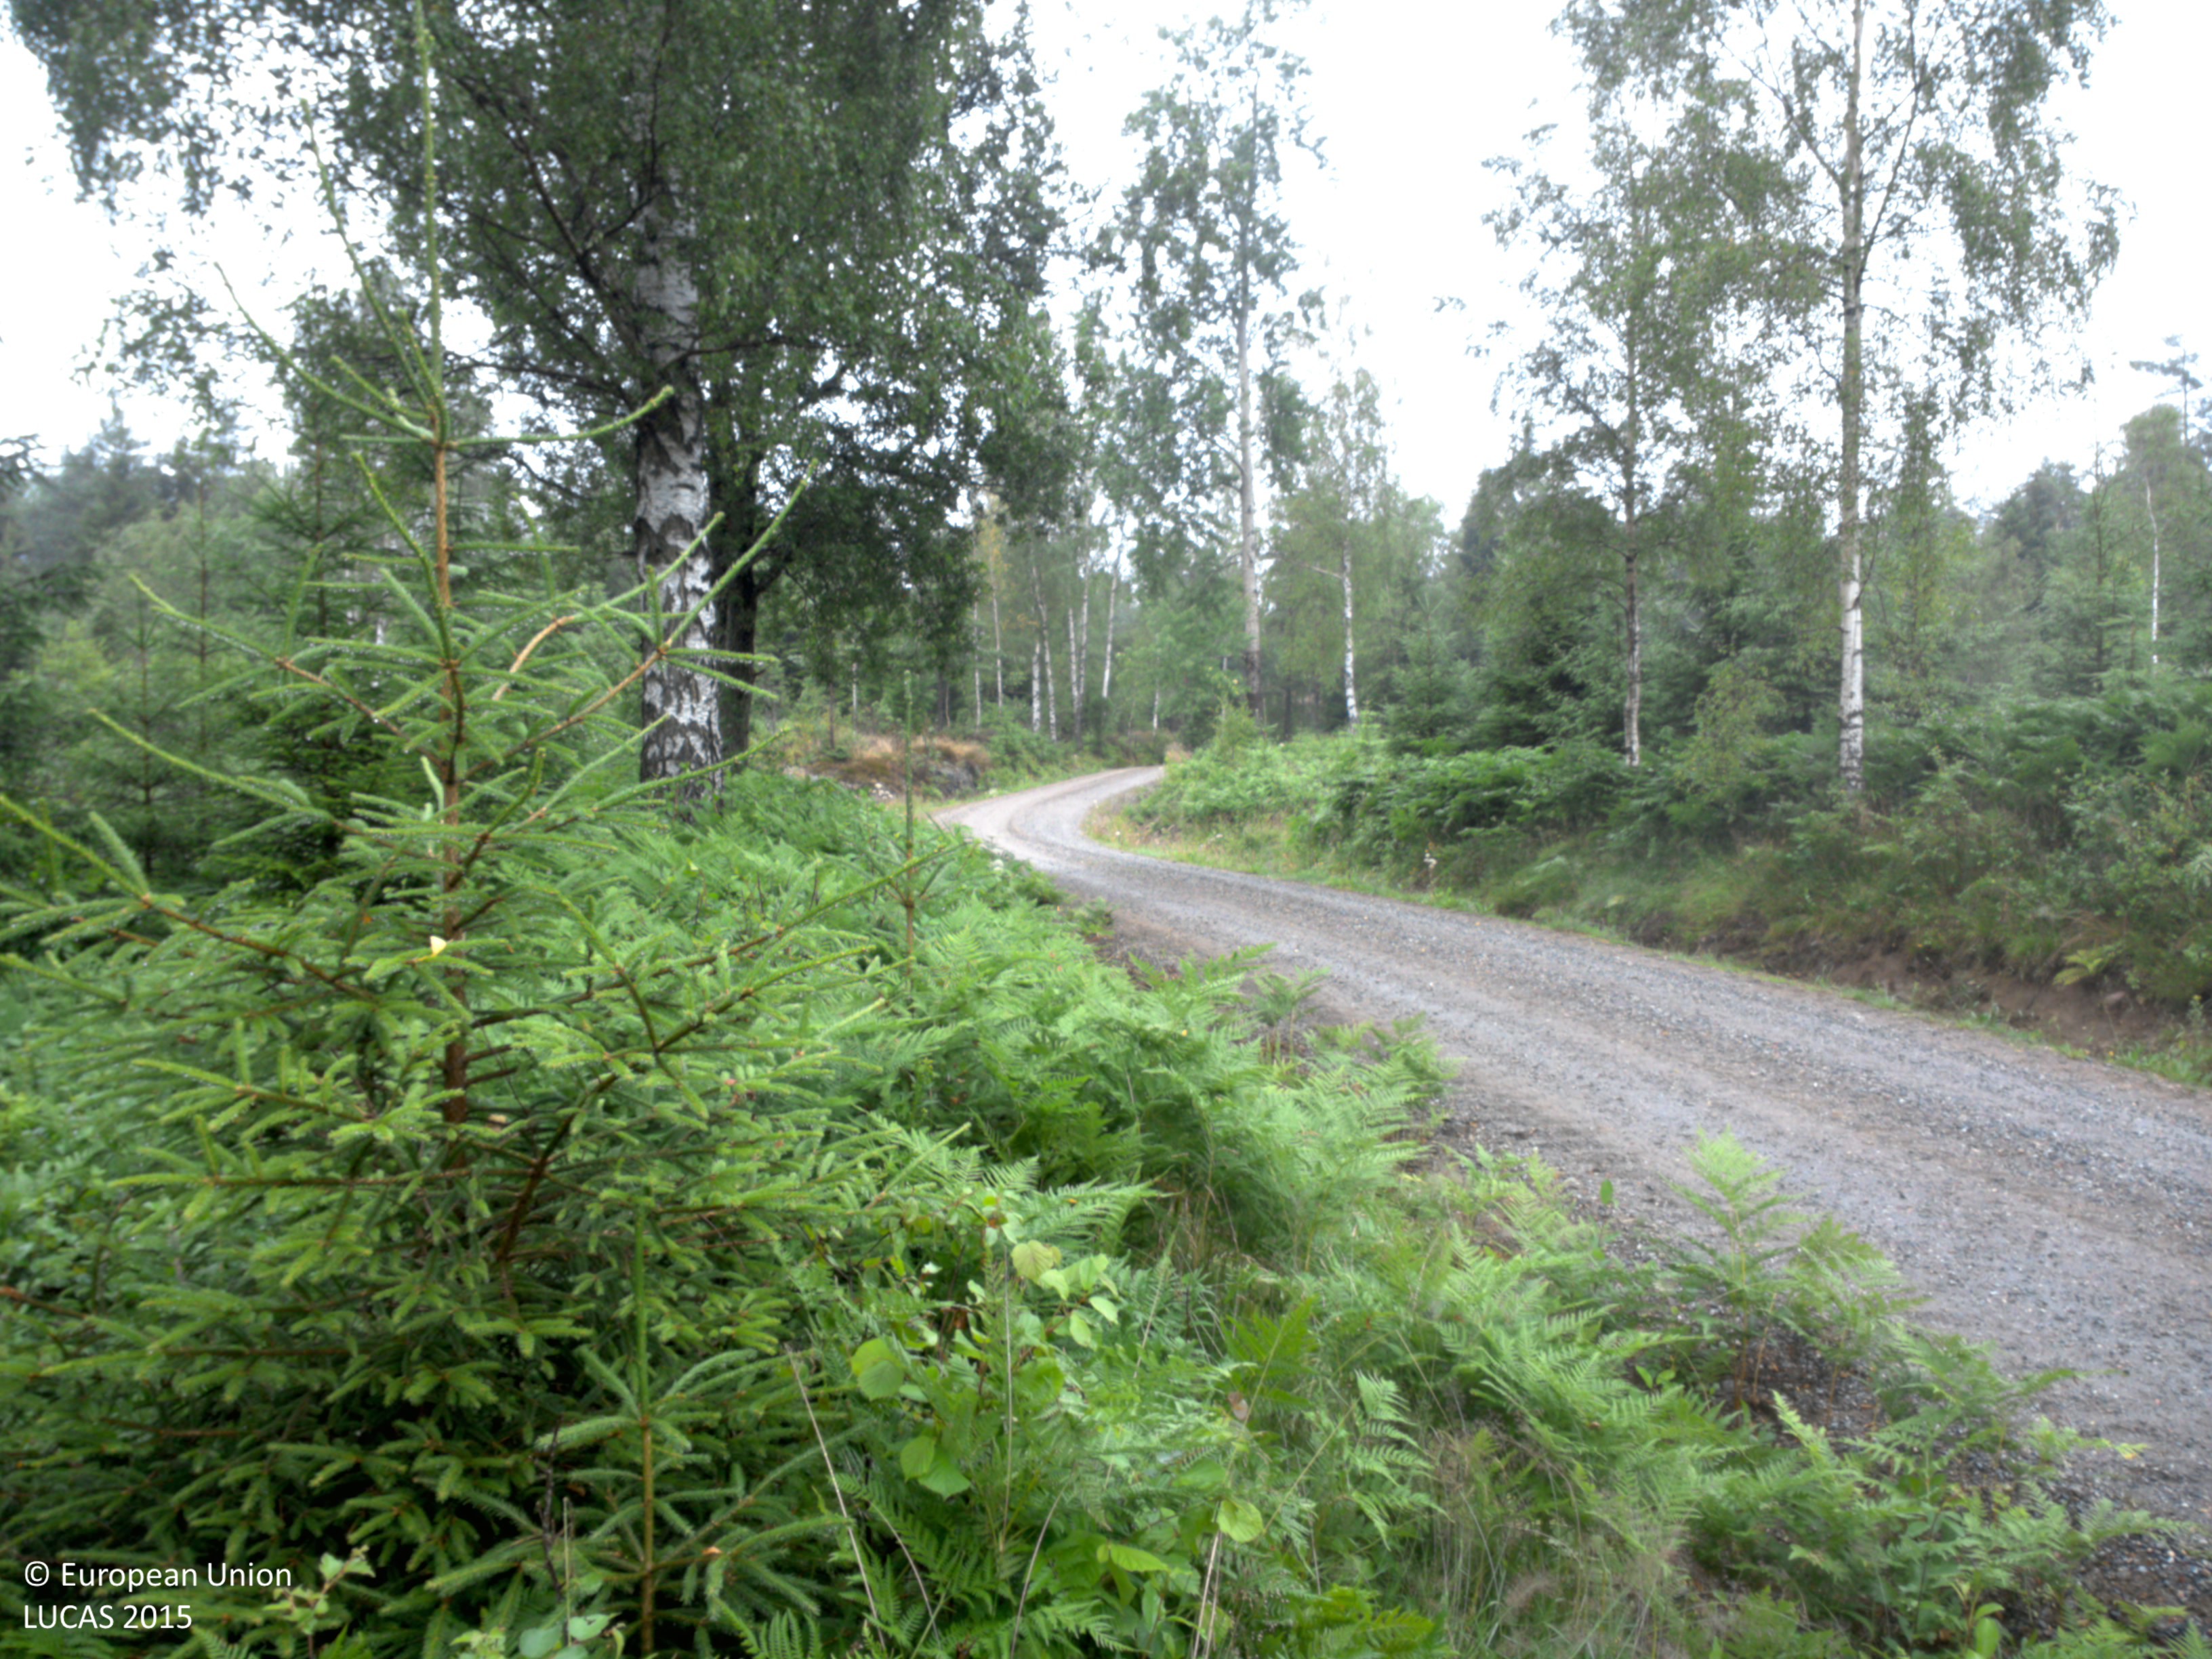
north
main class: Woodland
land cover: Spruce dominated mixed woodland
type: boreal forest
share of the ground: 50 - 75 %
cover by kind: coniferous forest trees 30 %, broadleaved forest trees 30 %, herbaceous plants 30 %, shrubs 10 %
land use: Forestry
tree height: > 5 m
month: July
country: SE
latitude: 58.6751
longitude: 11.8068
